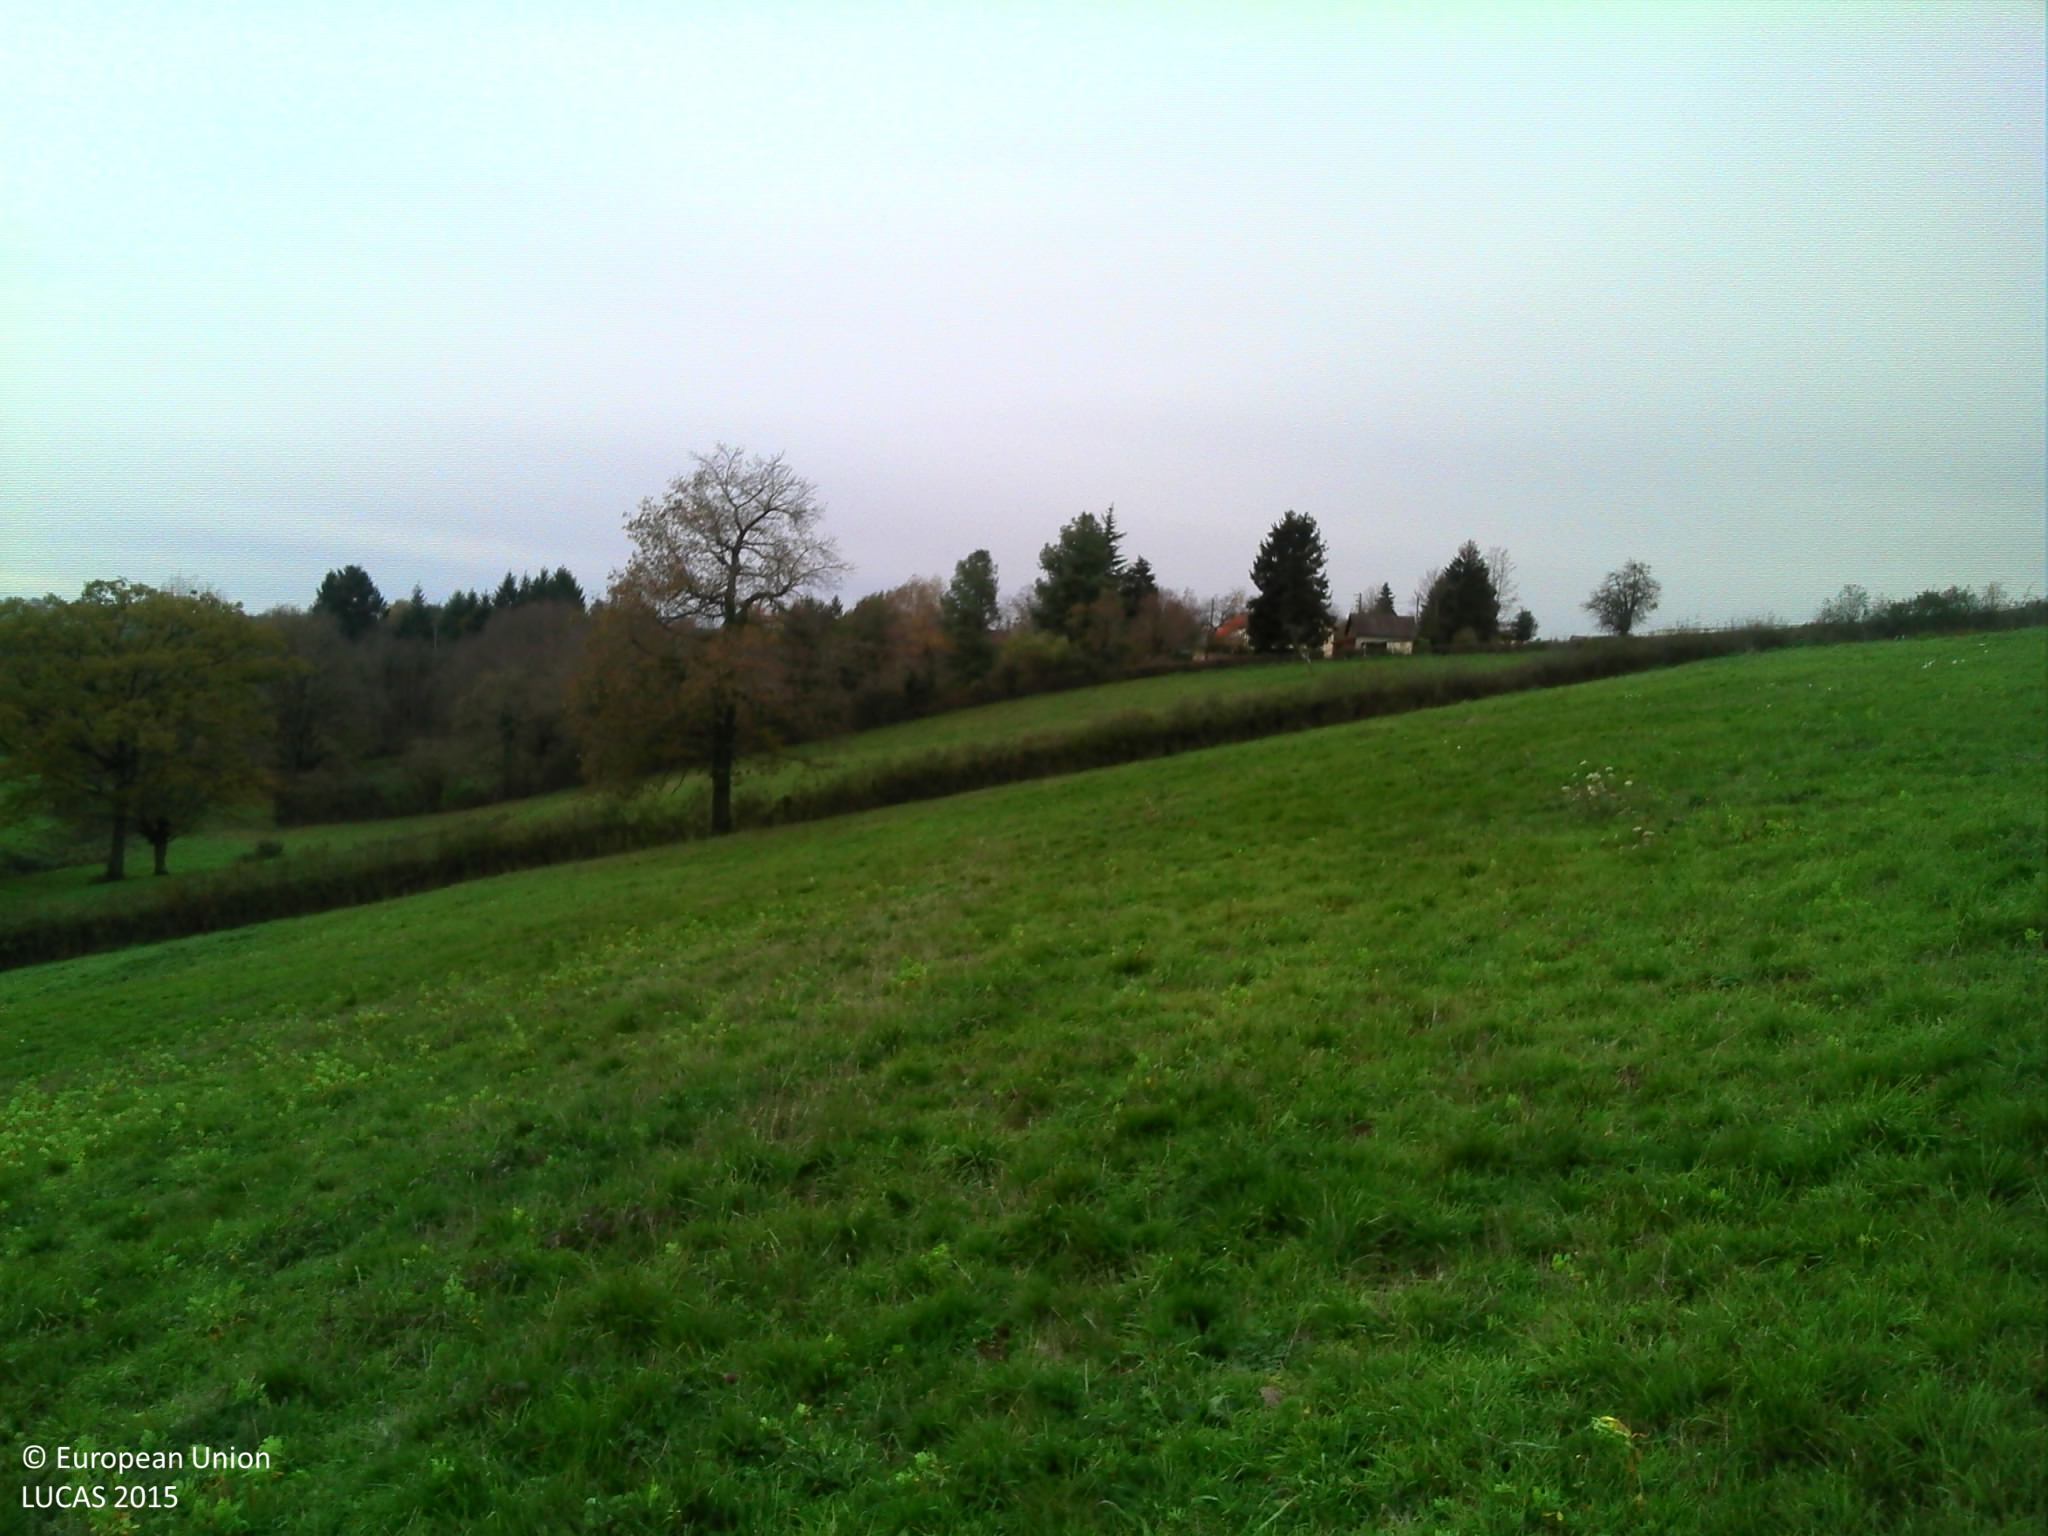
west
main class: Grassland
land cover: Grassland without tree/shrub cover
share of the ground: > 75 %
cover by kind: herbaceous plants 100 %
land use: Agriculture (excluding fallow land and kitchen gardens)
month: November
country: FR
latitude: 46.3639
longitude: 3.6958
